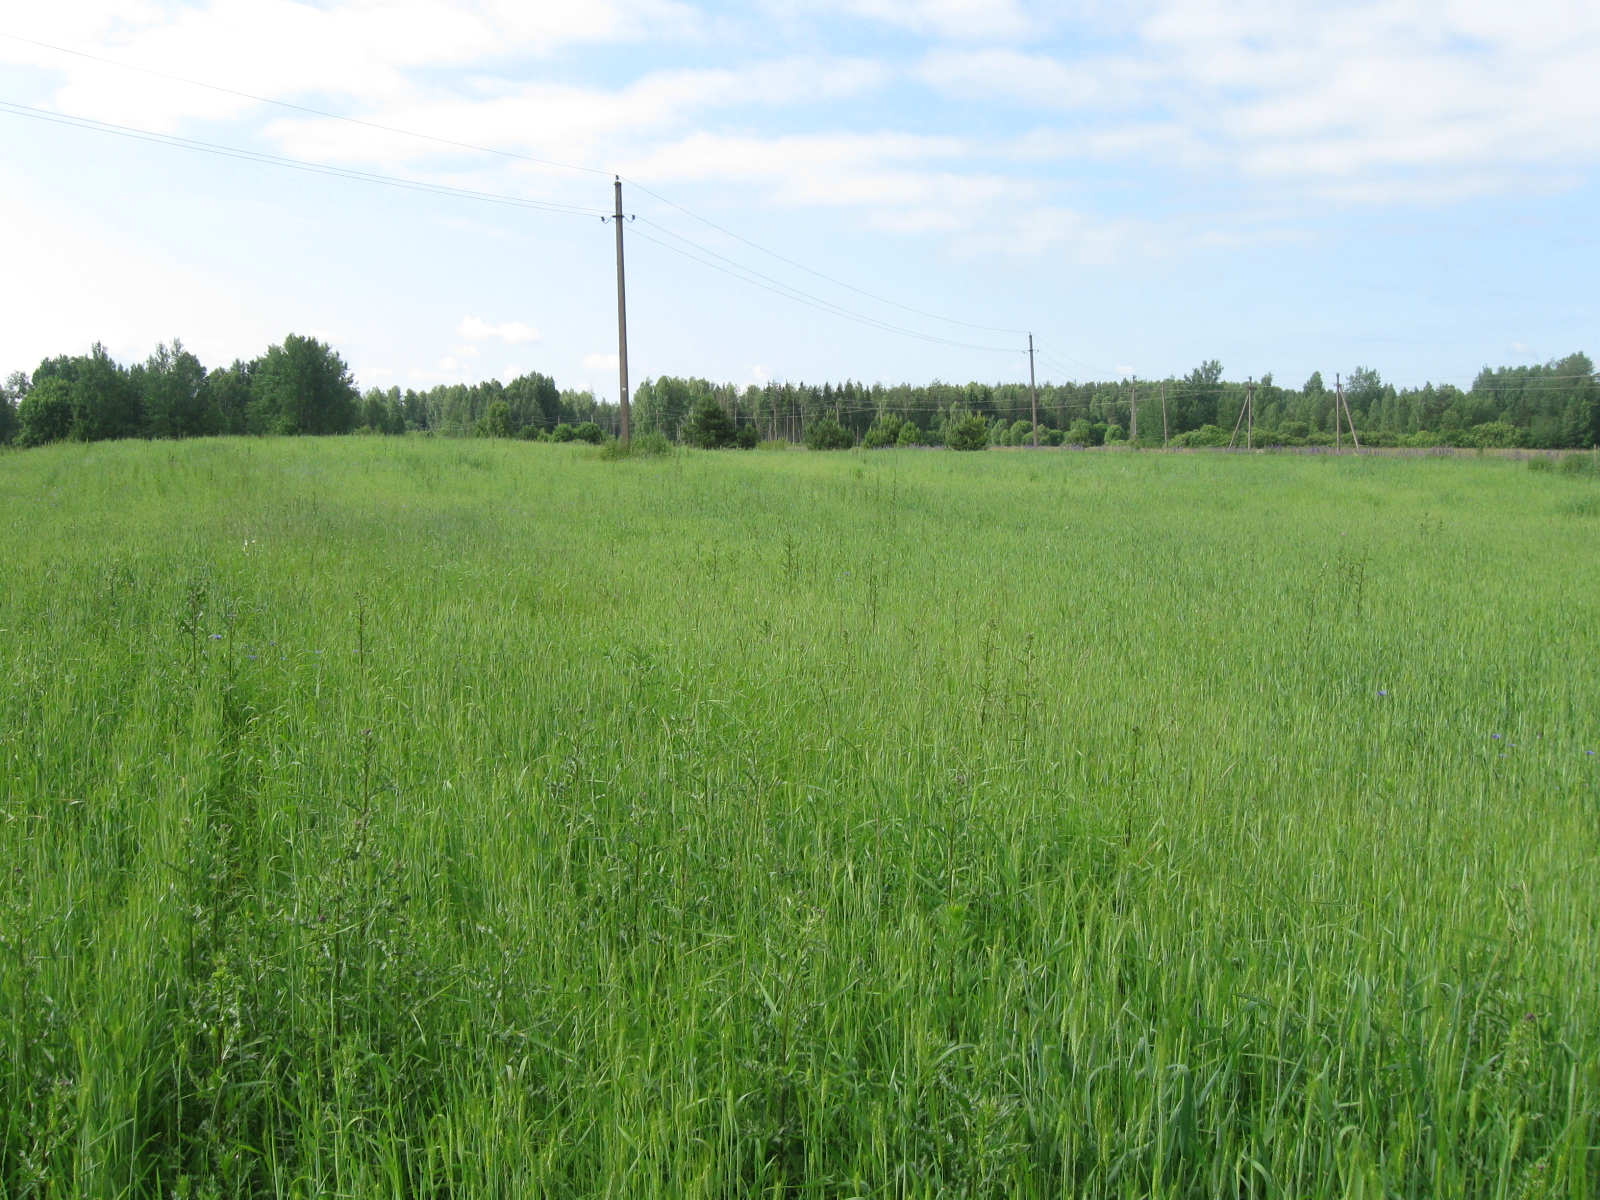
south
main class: Cropland
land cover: Barley
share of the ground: > 75 %
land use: Agriculture (excluding fallow land and kitchen gardens)
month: June
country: LT
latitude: 54.3312
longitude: 24.6703
